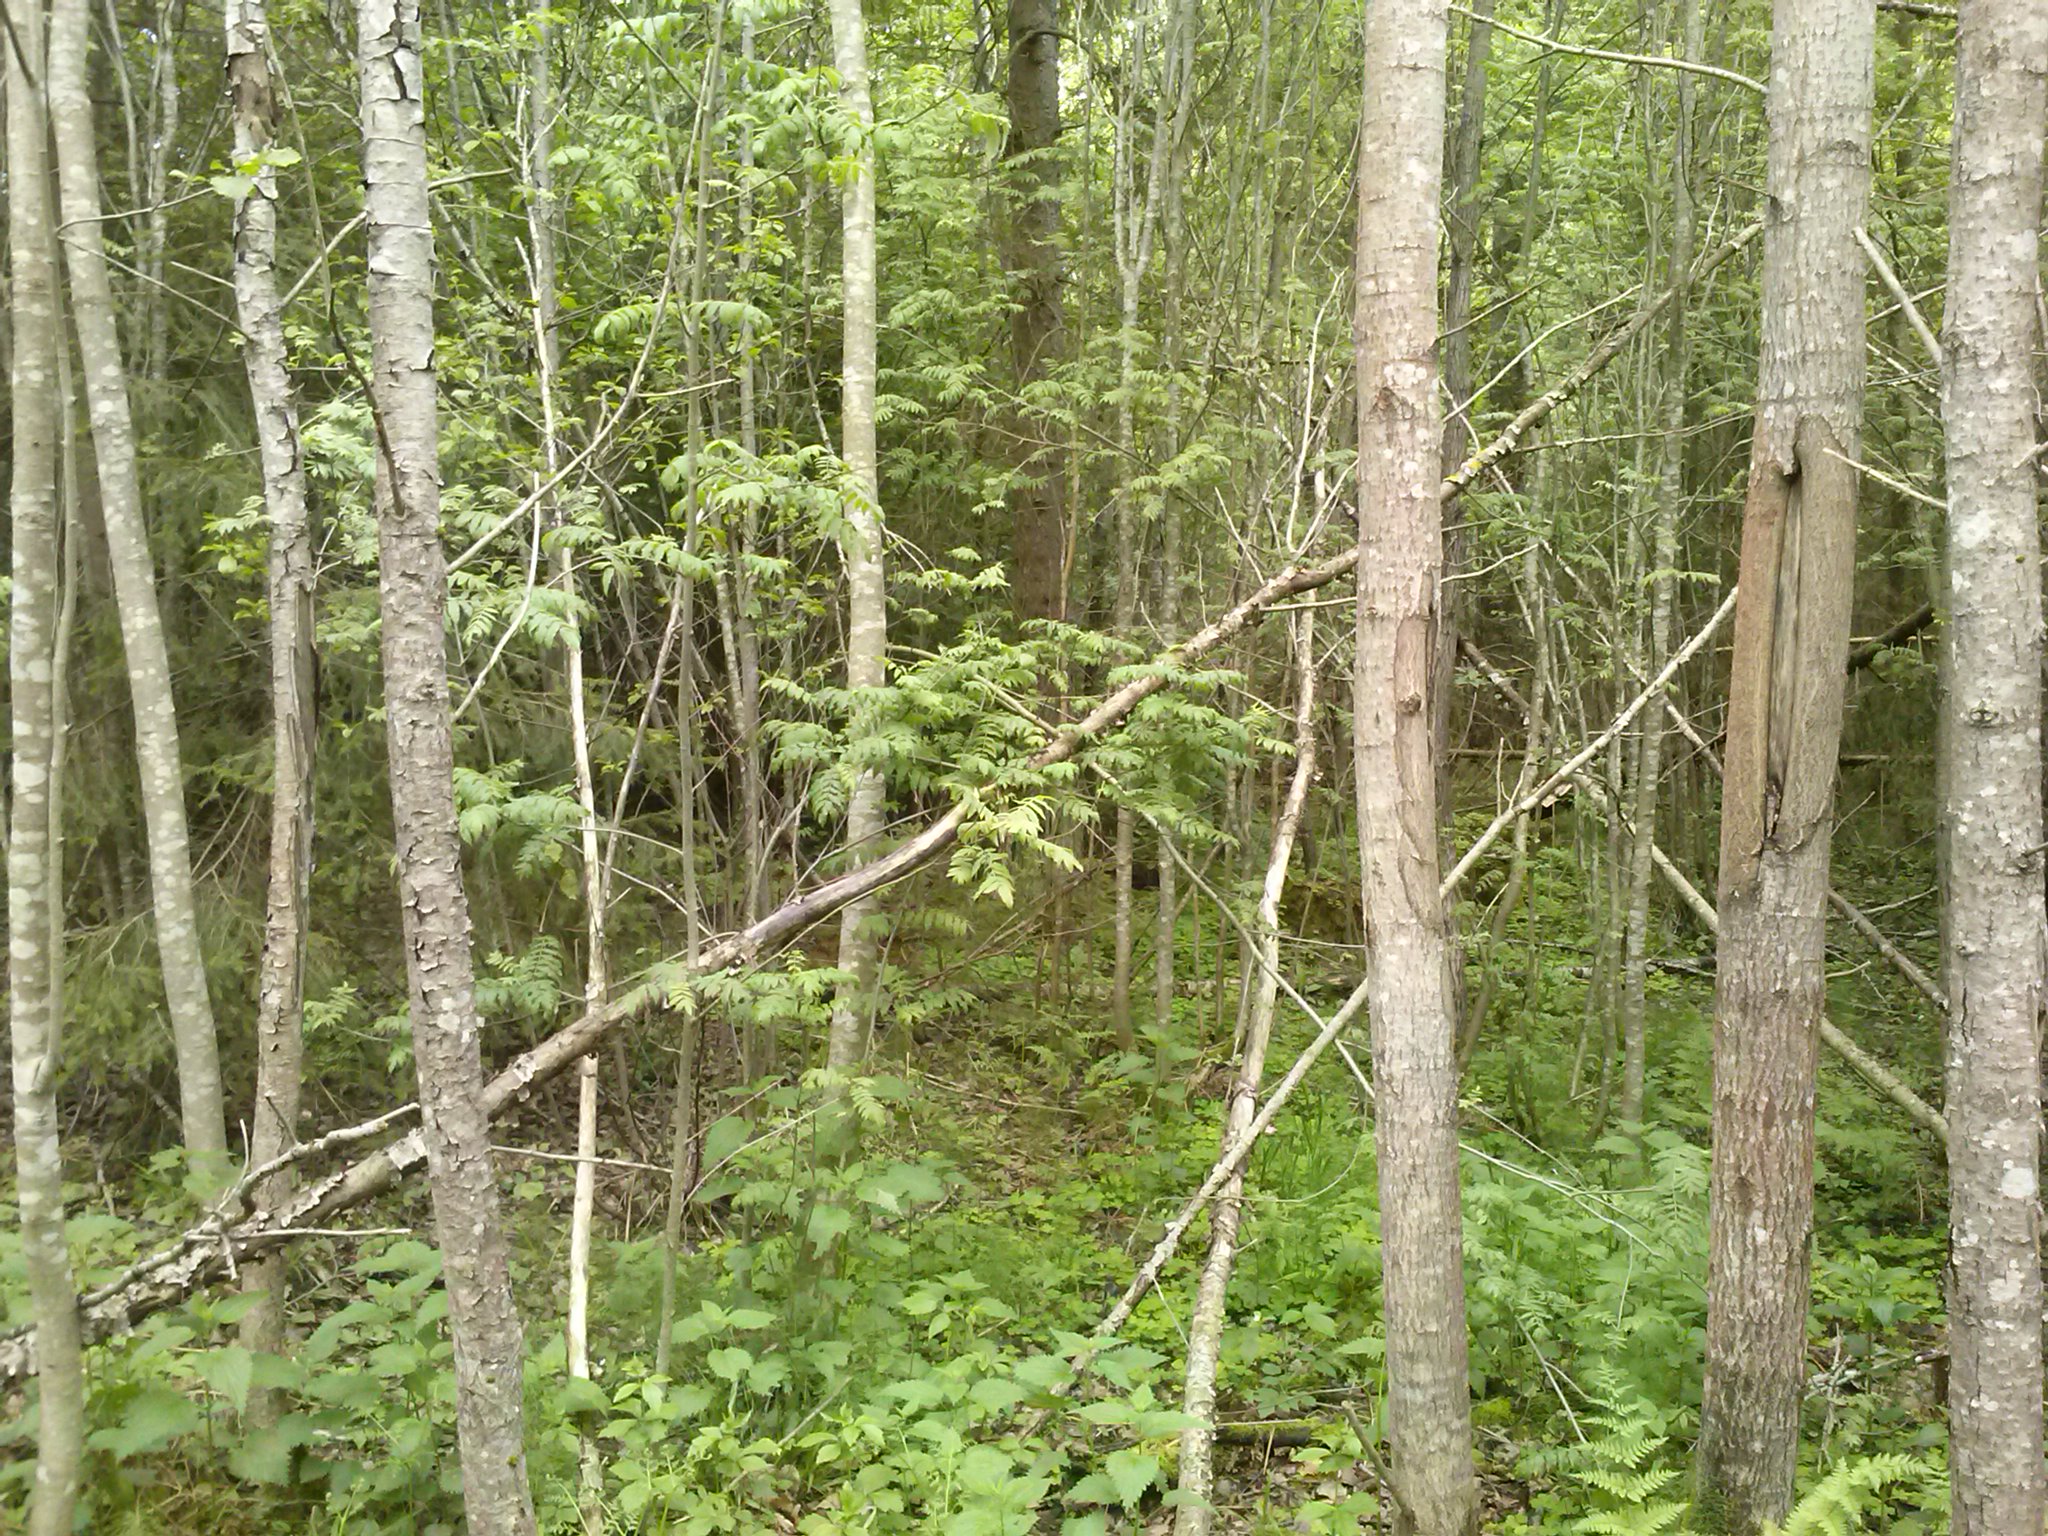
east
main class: Woodland
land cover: Broadleaved woodland
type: non-riverine alder, birch or aspen forest
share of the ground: > 75 %
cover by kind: broadleaved forest trees 80 %, coniferous forest trees 10 %, herbaceous plants 10 %
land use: Forestry
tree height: > 5 m
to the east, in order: Broadleaved woodland; Spruce dominated mixed woodland; Spruce dominated coniferous woodland; Spruce dominated mixed woodland; Ditches and canals; Spruce dominated mixed woodland; Broadleaved woodland
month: May
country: LV
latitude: 56.2270
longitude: 27.7542
